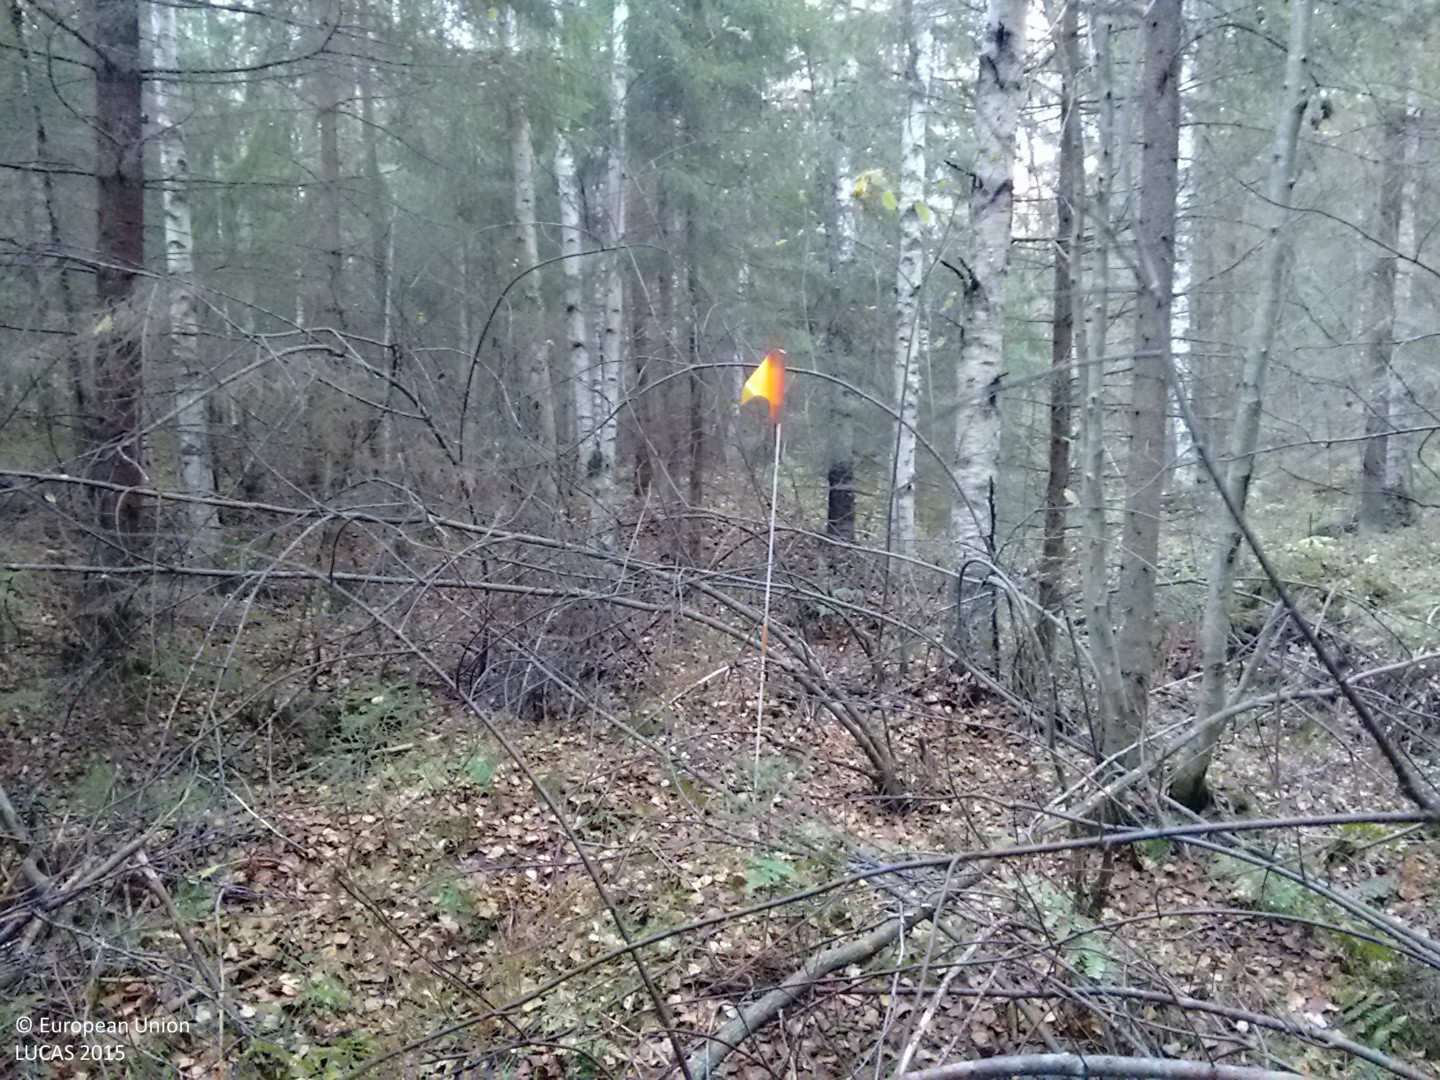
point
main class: Woodland
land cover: Spruce dominated mixed woodland
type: boreal forest
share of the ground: > 75 %
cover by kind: coniferous forest trees 55 %, broadleaved forest trees 45 %
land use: Forestry
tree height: > 5 m
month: October
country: FI
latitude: 62.3345
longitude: 26.2131
